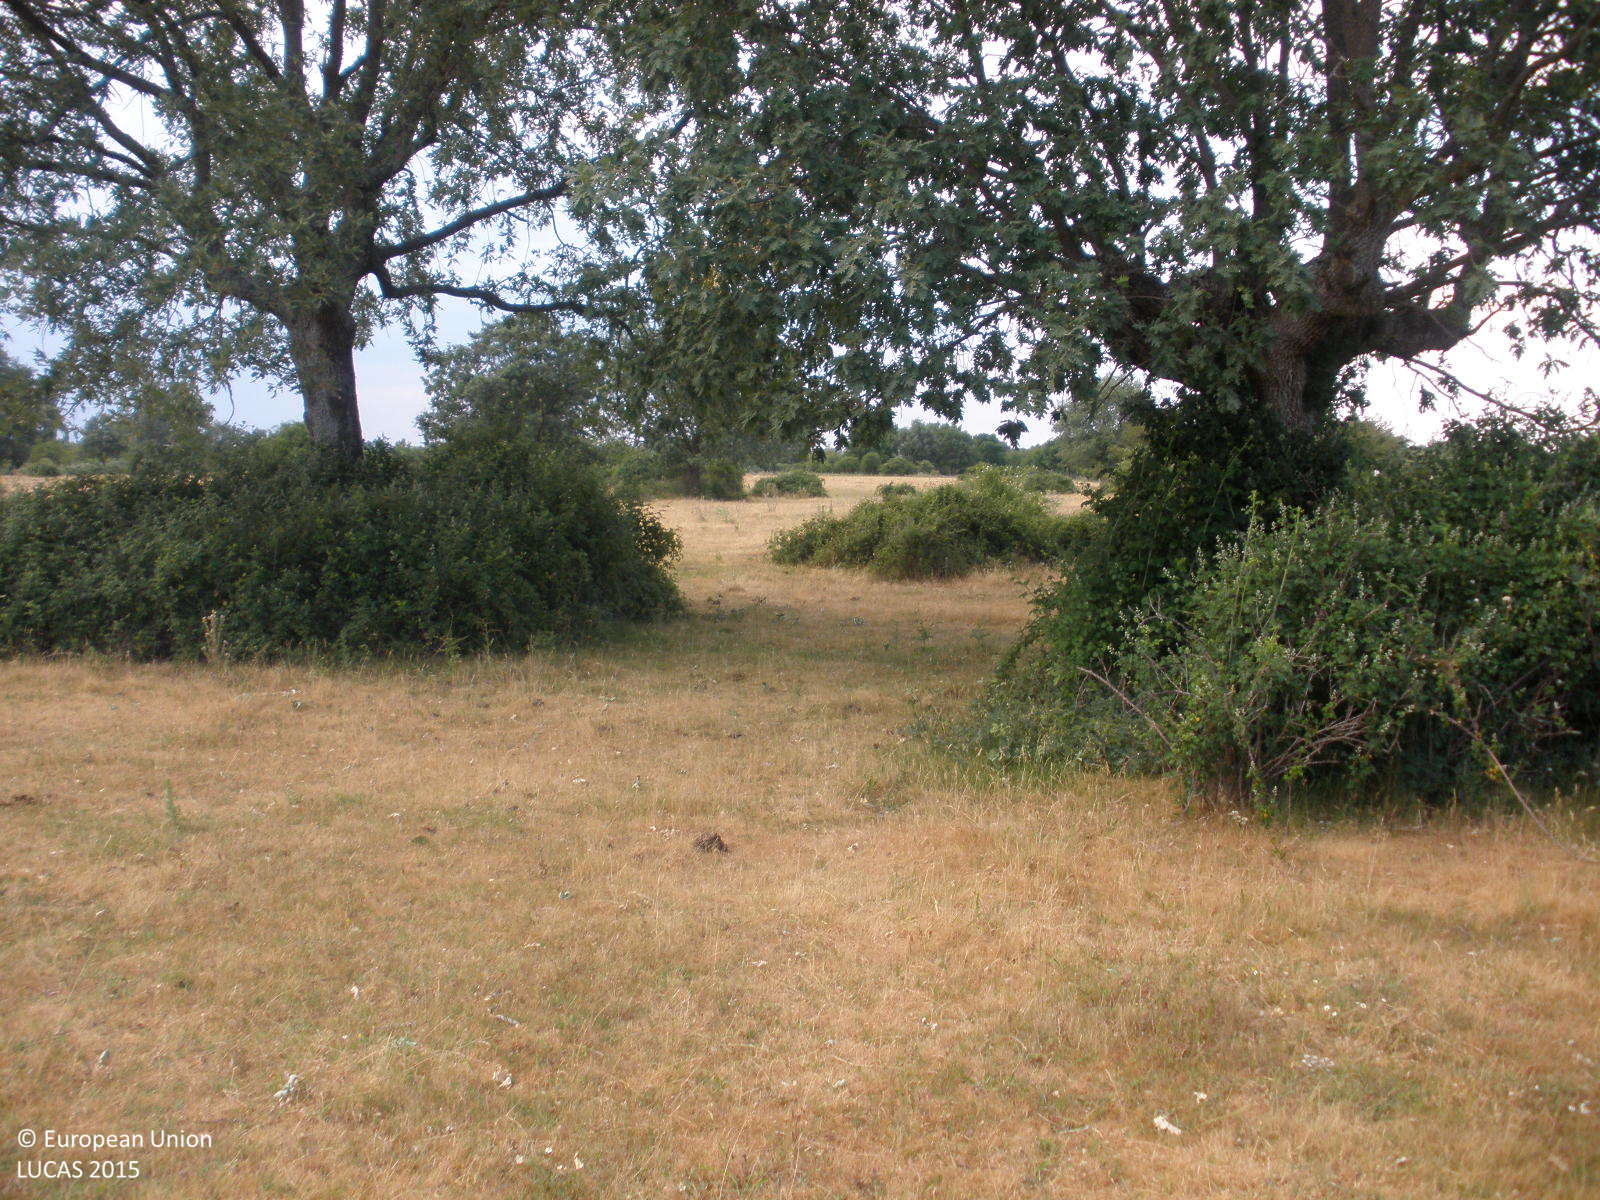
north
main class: Grassland
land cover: Grassland with sparse tree/shrub cover
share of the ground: > 75 %
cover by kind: herbaceous plants 85 %, shrubs 10 %, broadleaved forest trees 5 %
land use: Agriculture (excluding fallow land and kitchen gardens)
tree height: > 5 m
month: June
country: ES
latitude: 40.7097
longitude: -6.3391
